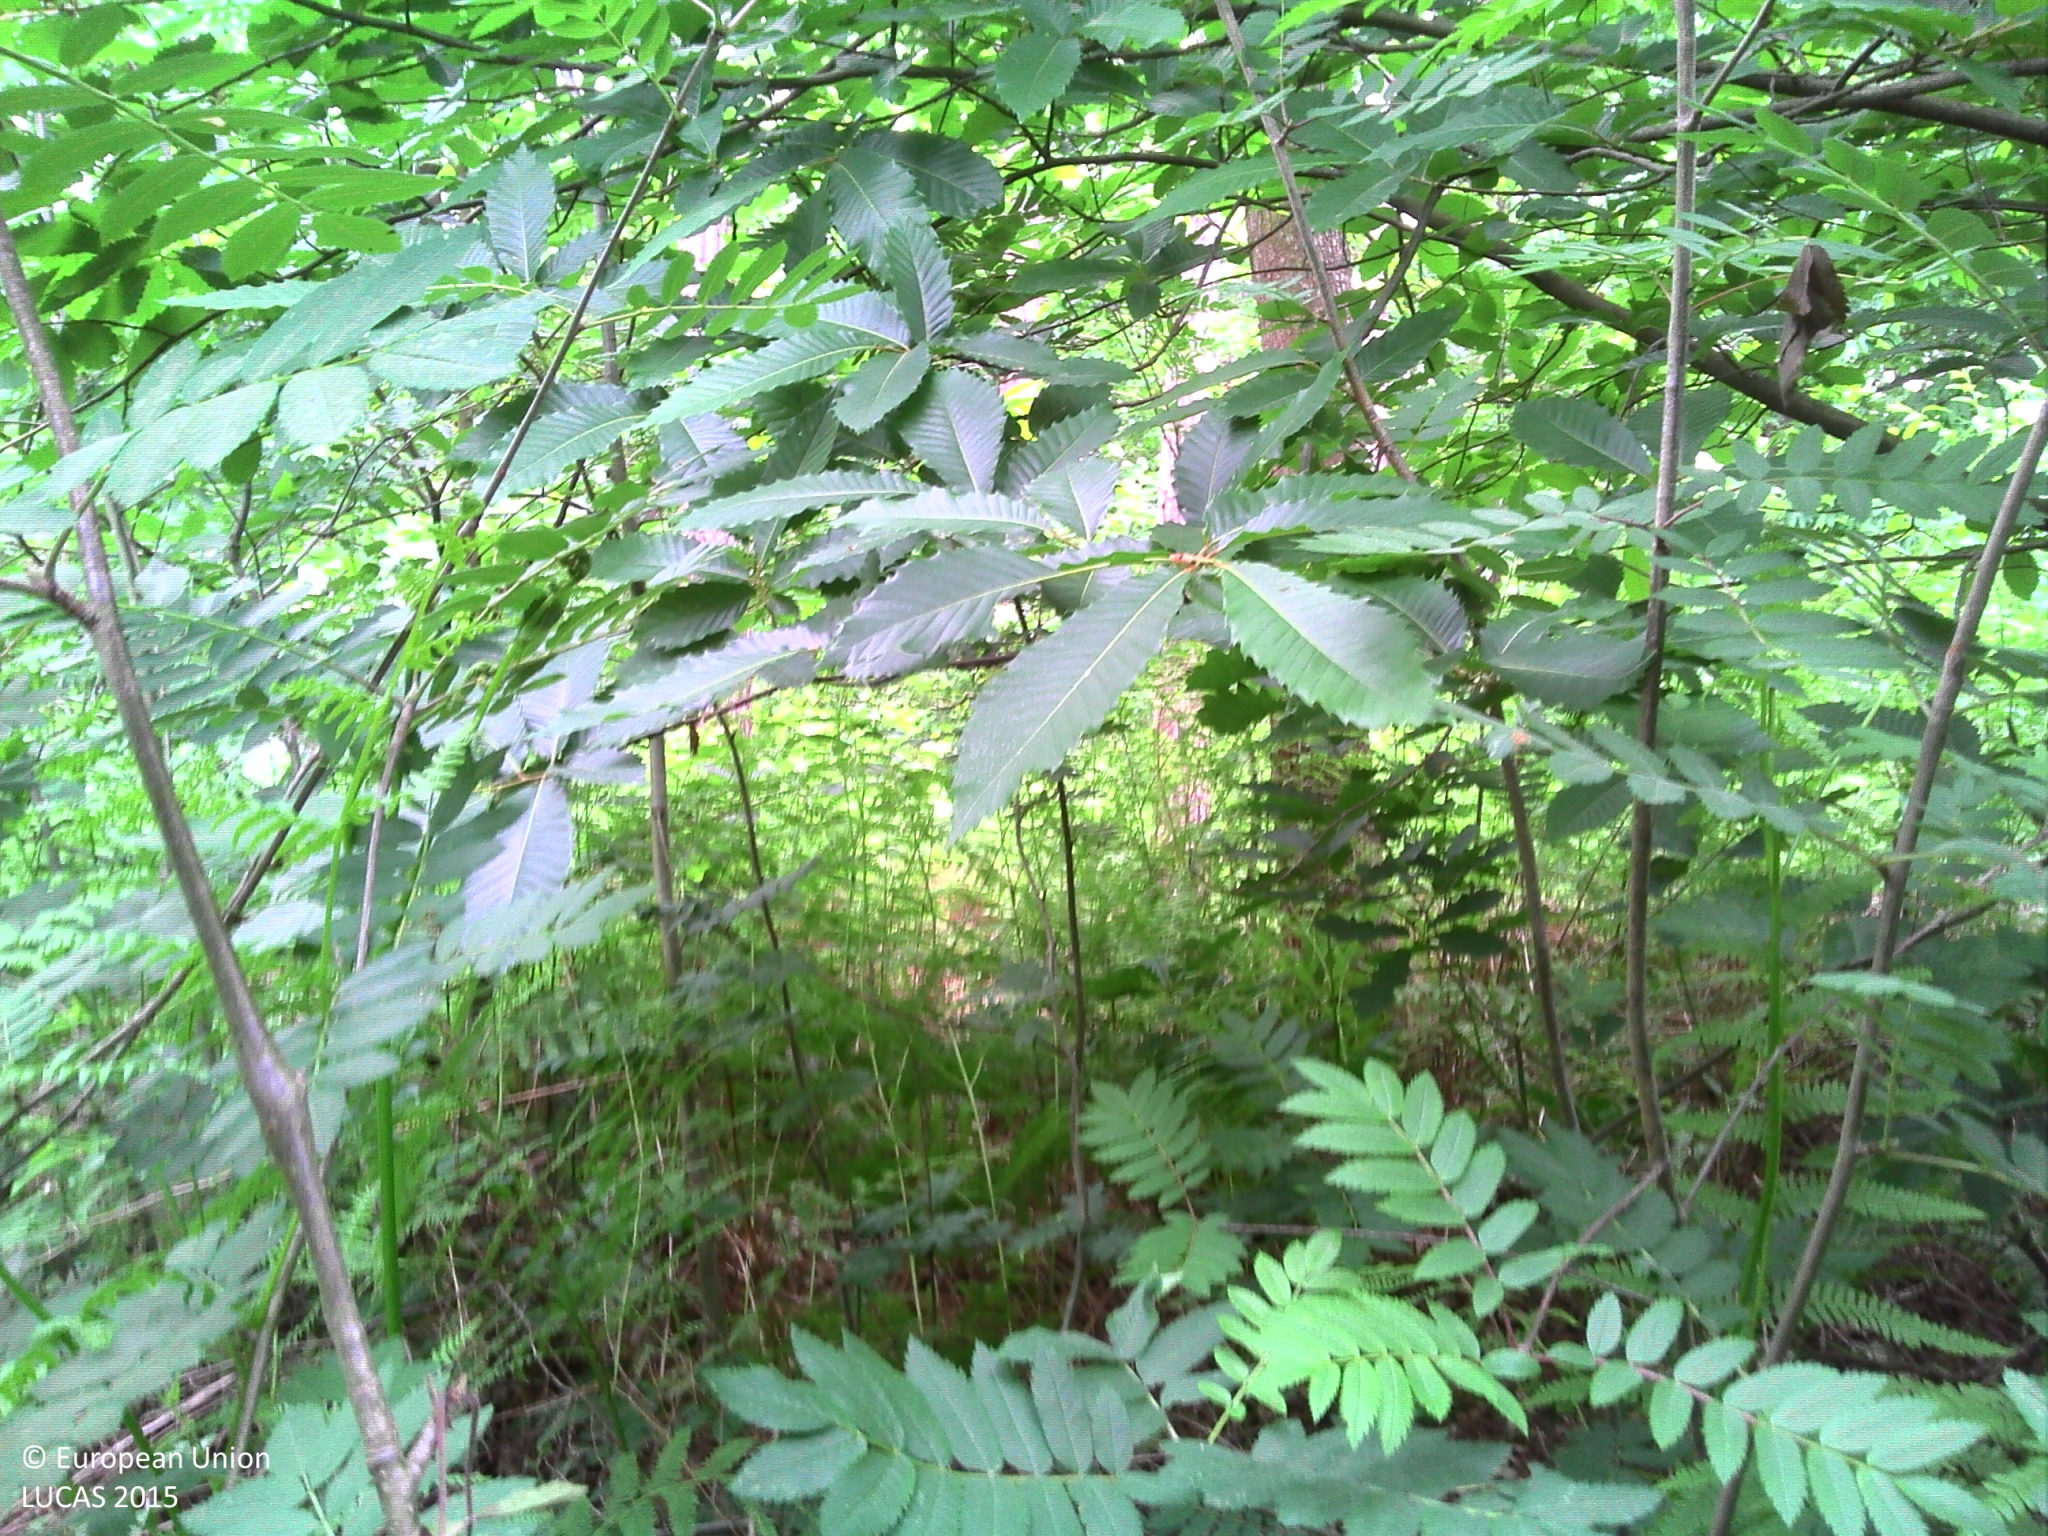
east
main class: Woodland
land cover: Pine dominated mixed woodland
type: acidophilous oak and oak-birch forest
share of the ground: > 75 %
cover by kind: broadleaved forest trees 40 %, shrubs 35 %, coniferous forest trees 20 %, herbaceous plants 5 %
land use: Forestry
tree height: > 5 m
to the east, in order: Pine dominated mixed woodland; Spontaneously vegetated surfaces; Tracks; Spontaneously vegetated surfaces; Ditches and canals; Other mixed woodland
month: June
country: BE
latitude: 50.8526
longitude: 2.9869
